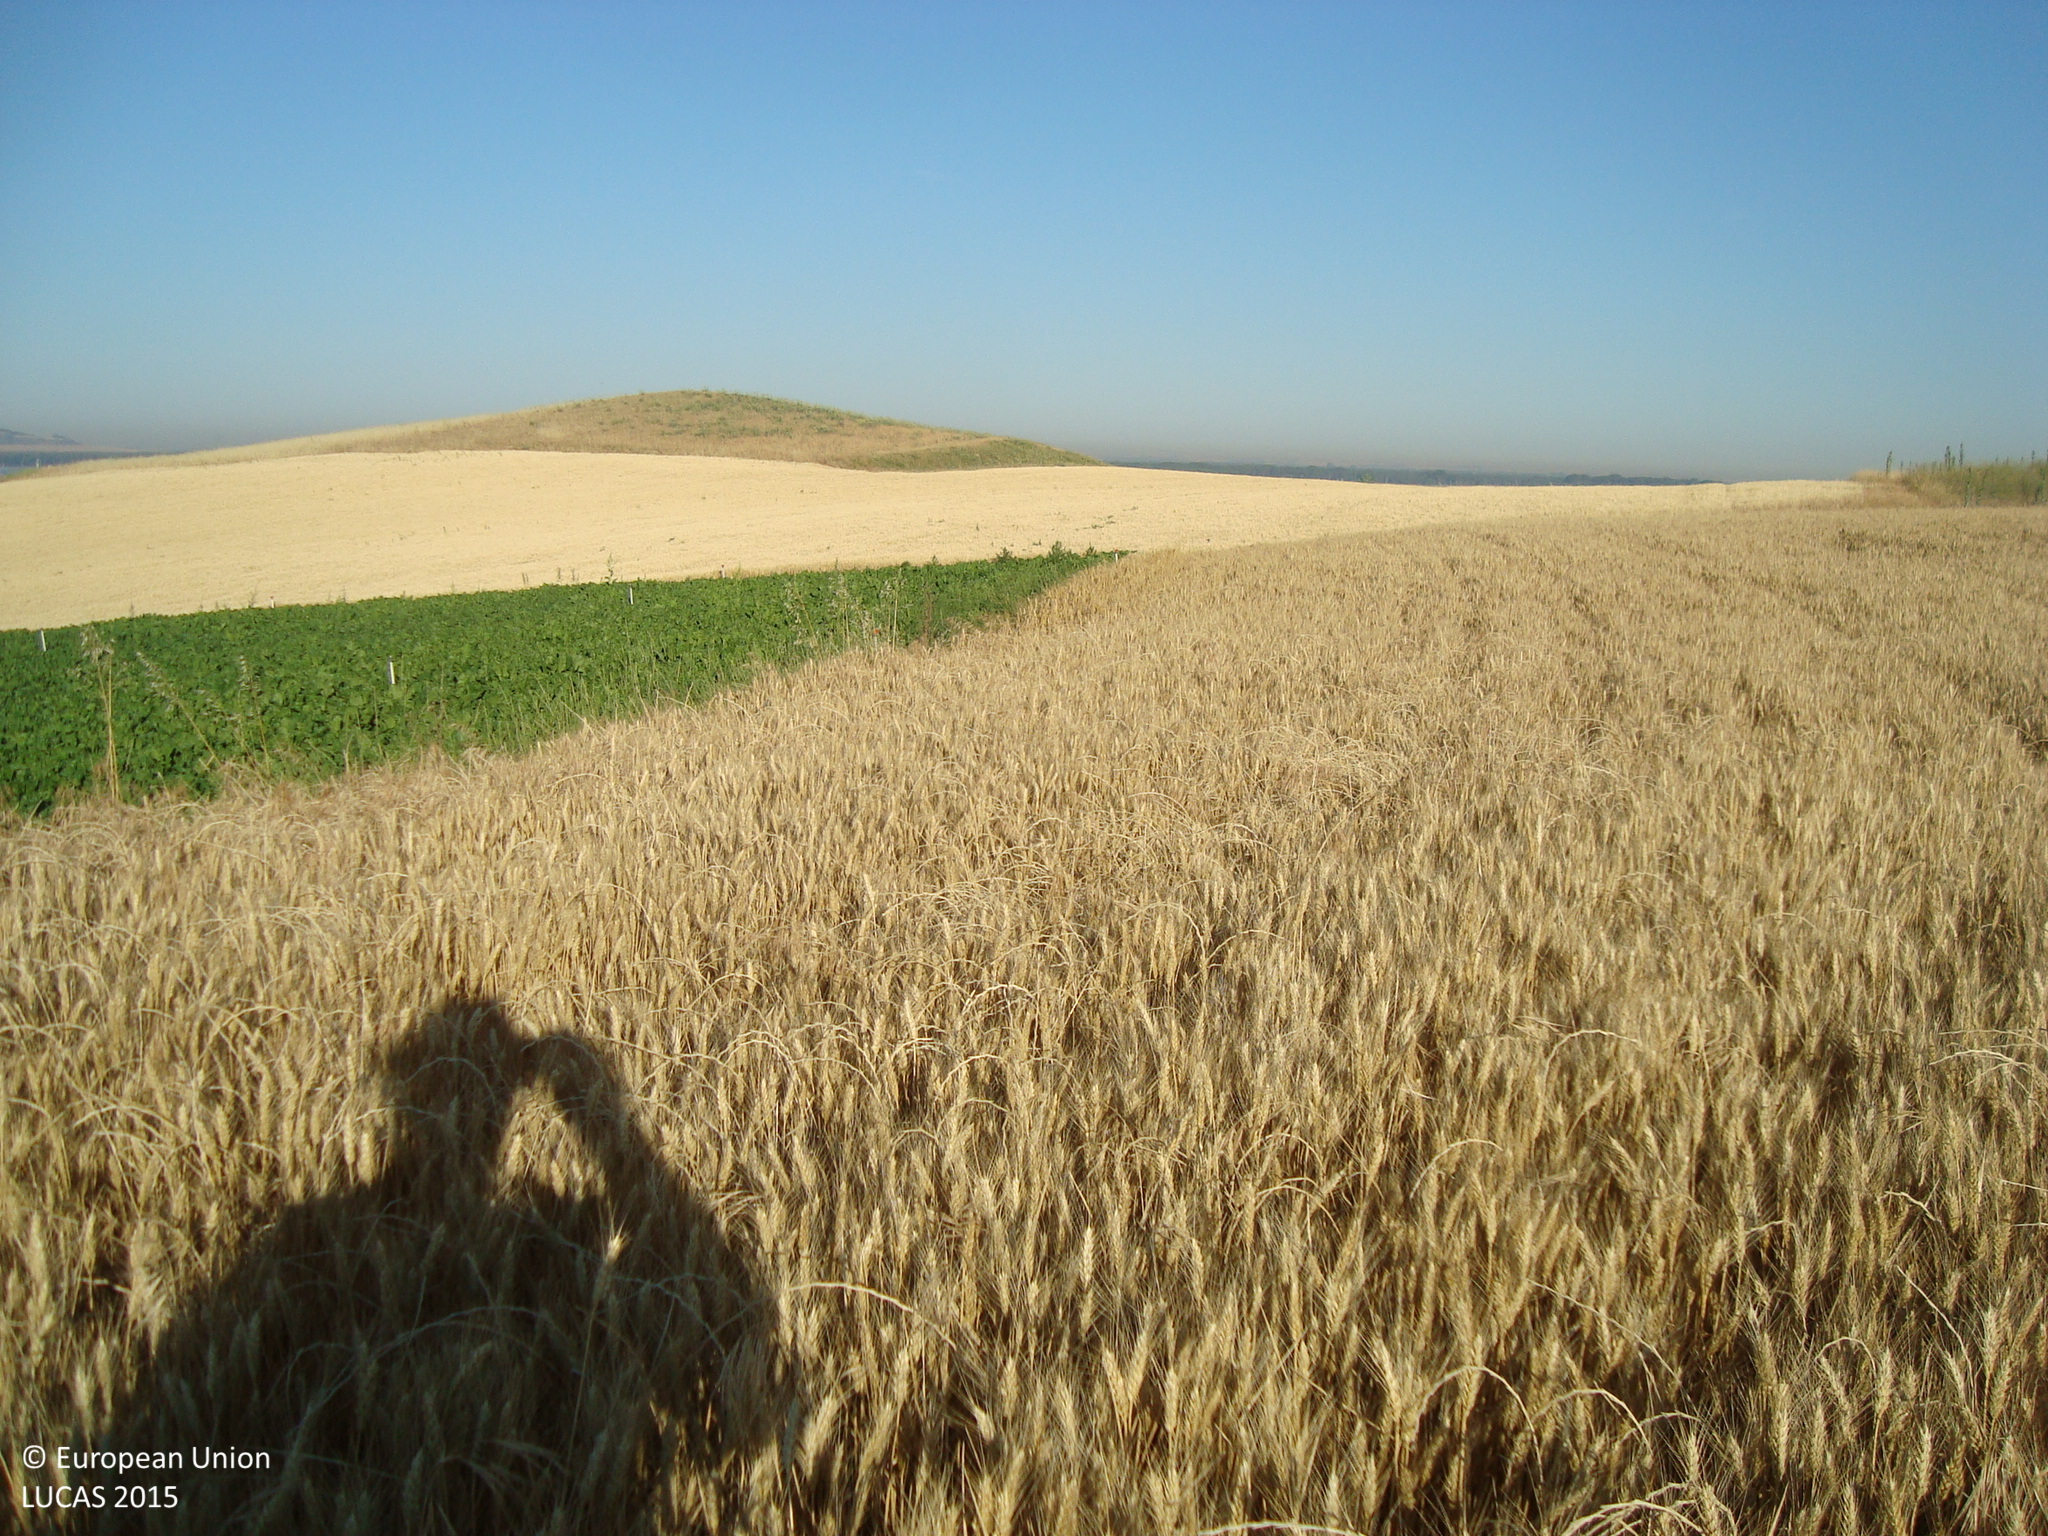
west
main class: Cropland
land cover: Common wheat
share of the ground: > 75 %
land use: Agriculture (excluding fallow land and kitchen gardens)
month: June
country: ES
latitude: 41.3535
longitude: -4.5853
